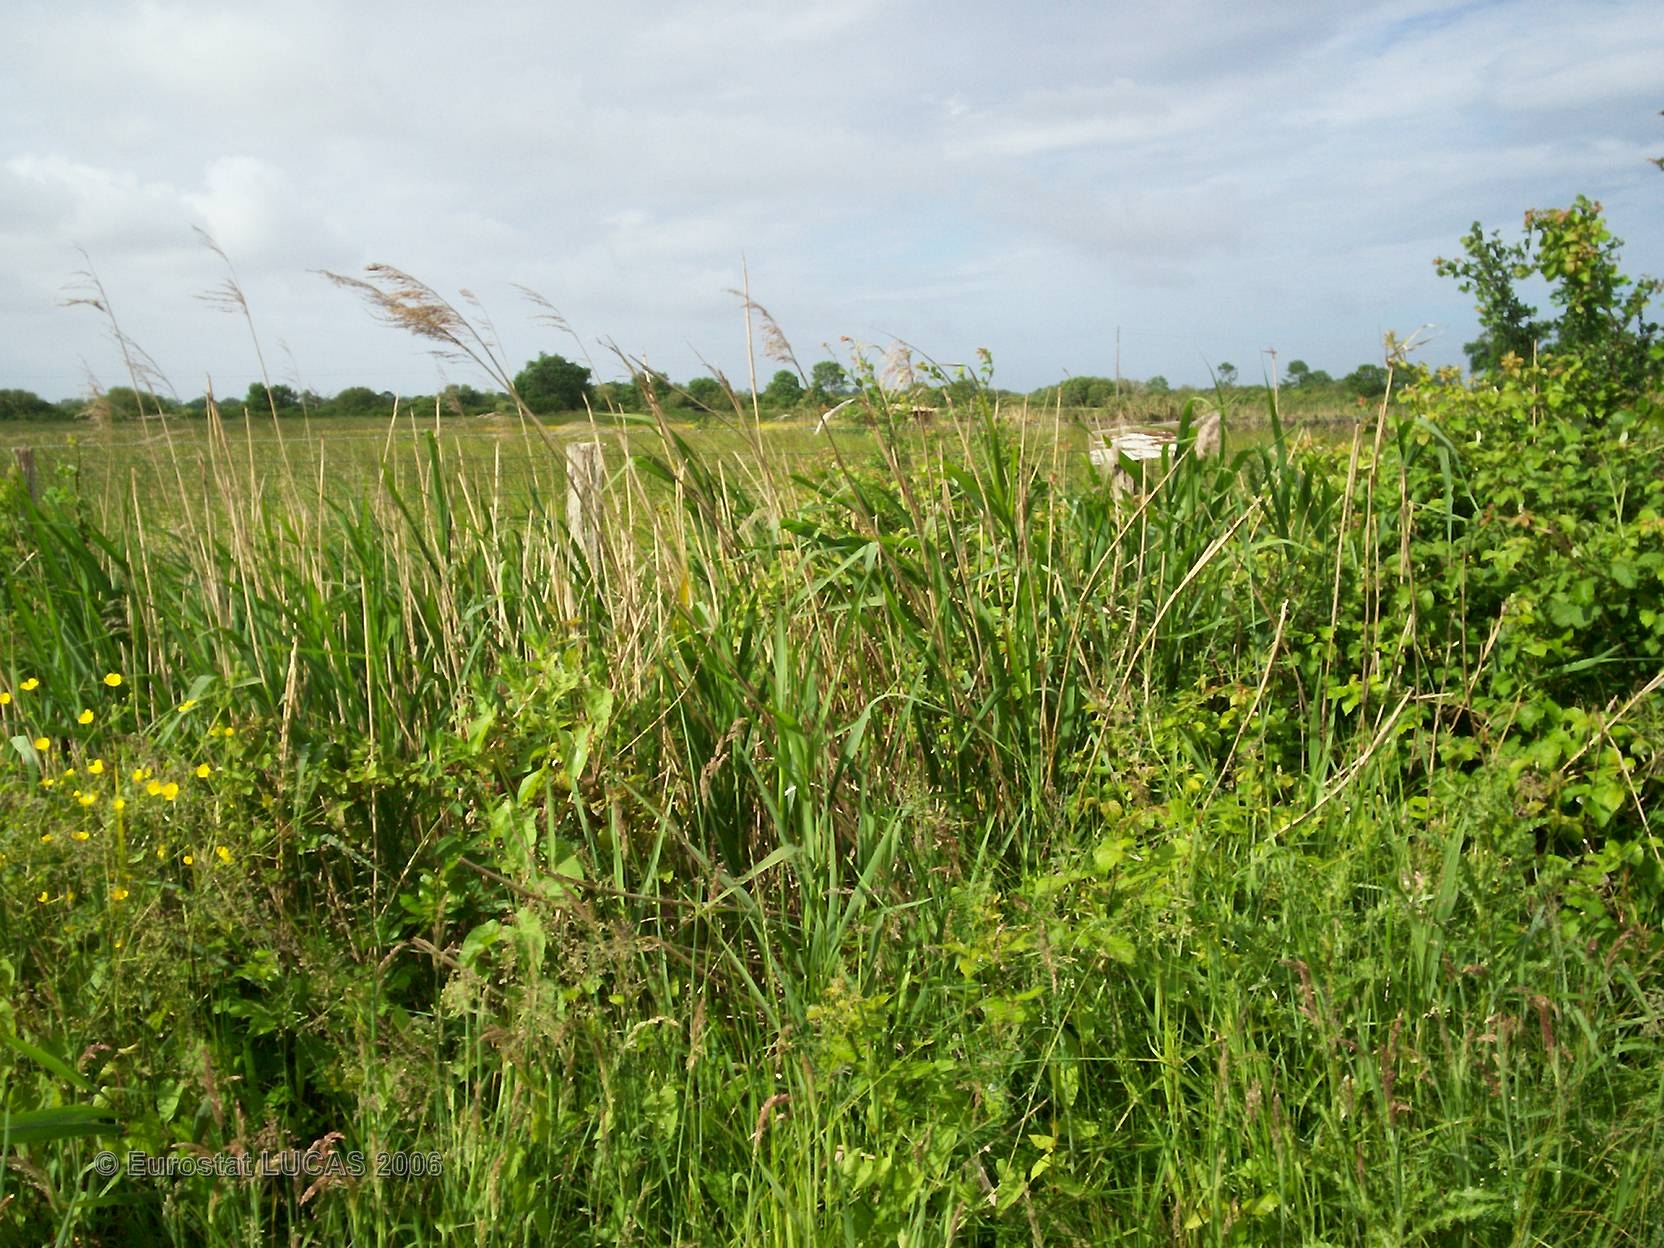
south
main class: Grassland
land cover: Grassland without tree/shrub cover
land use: Agriculture (excluding fallow land and kitchen gardens)
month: May
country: FR
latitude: 45.3853
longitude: -0.9710
